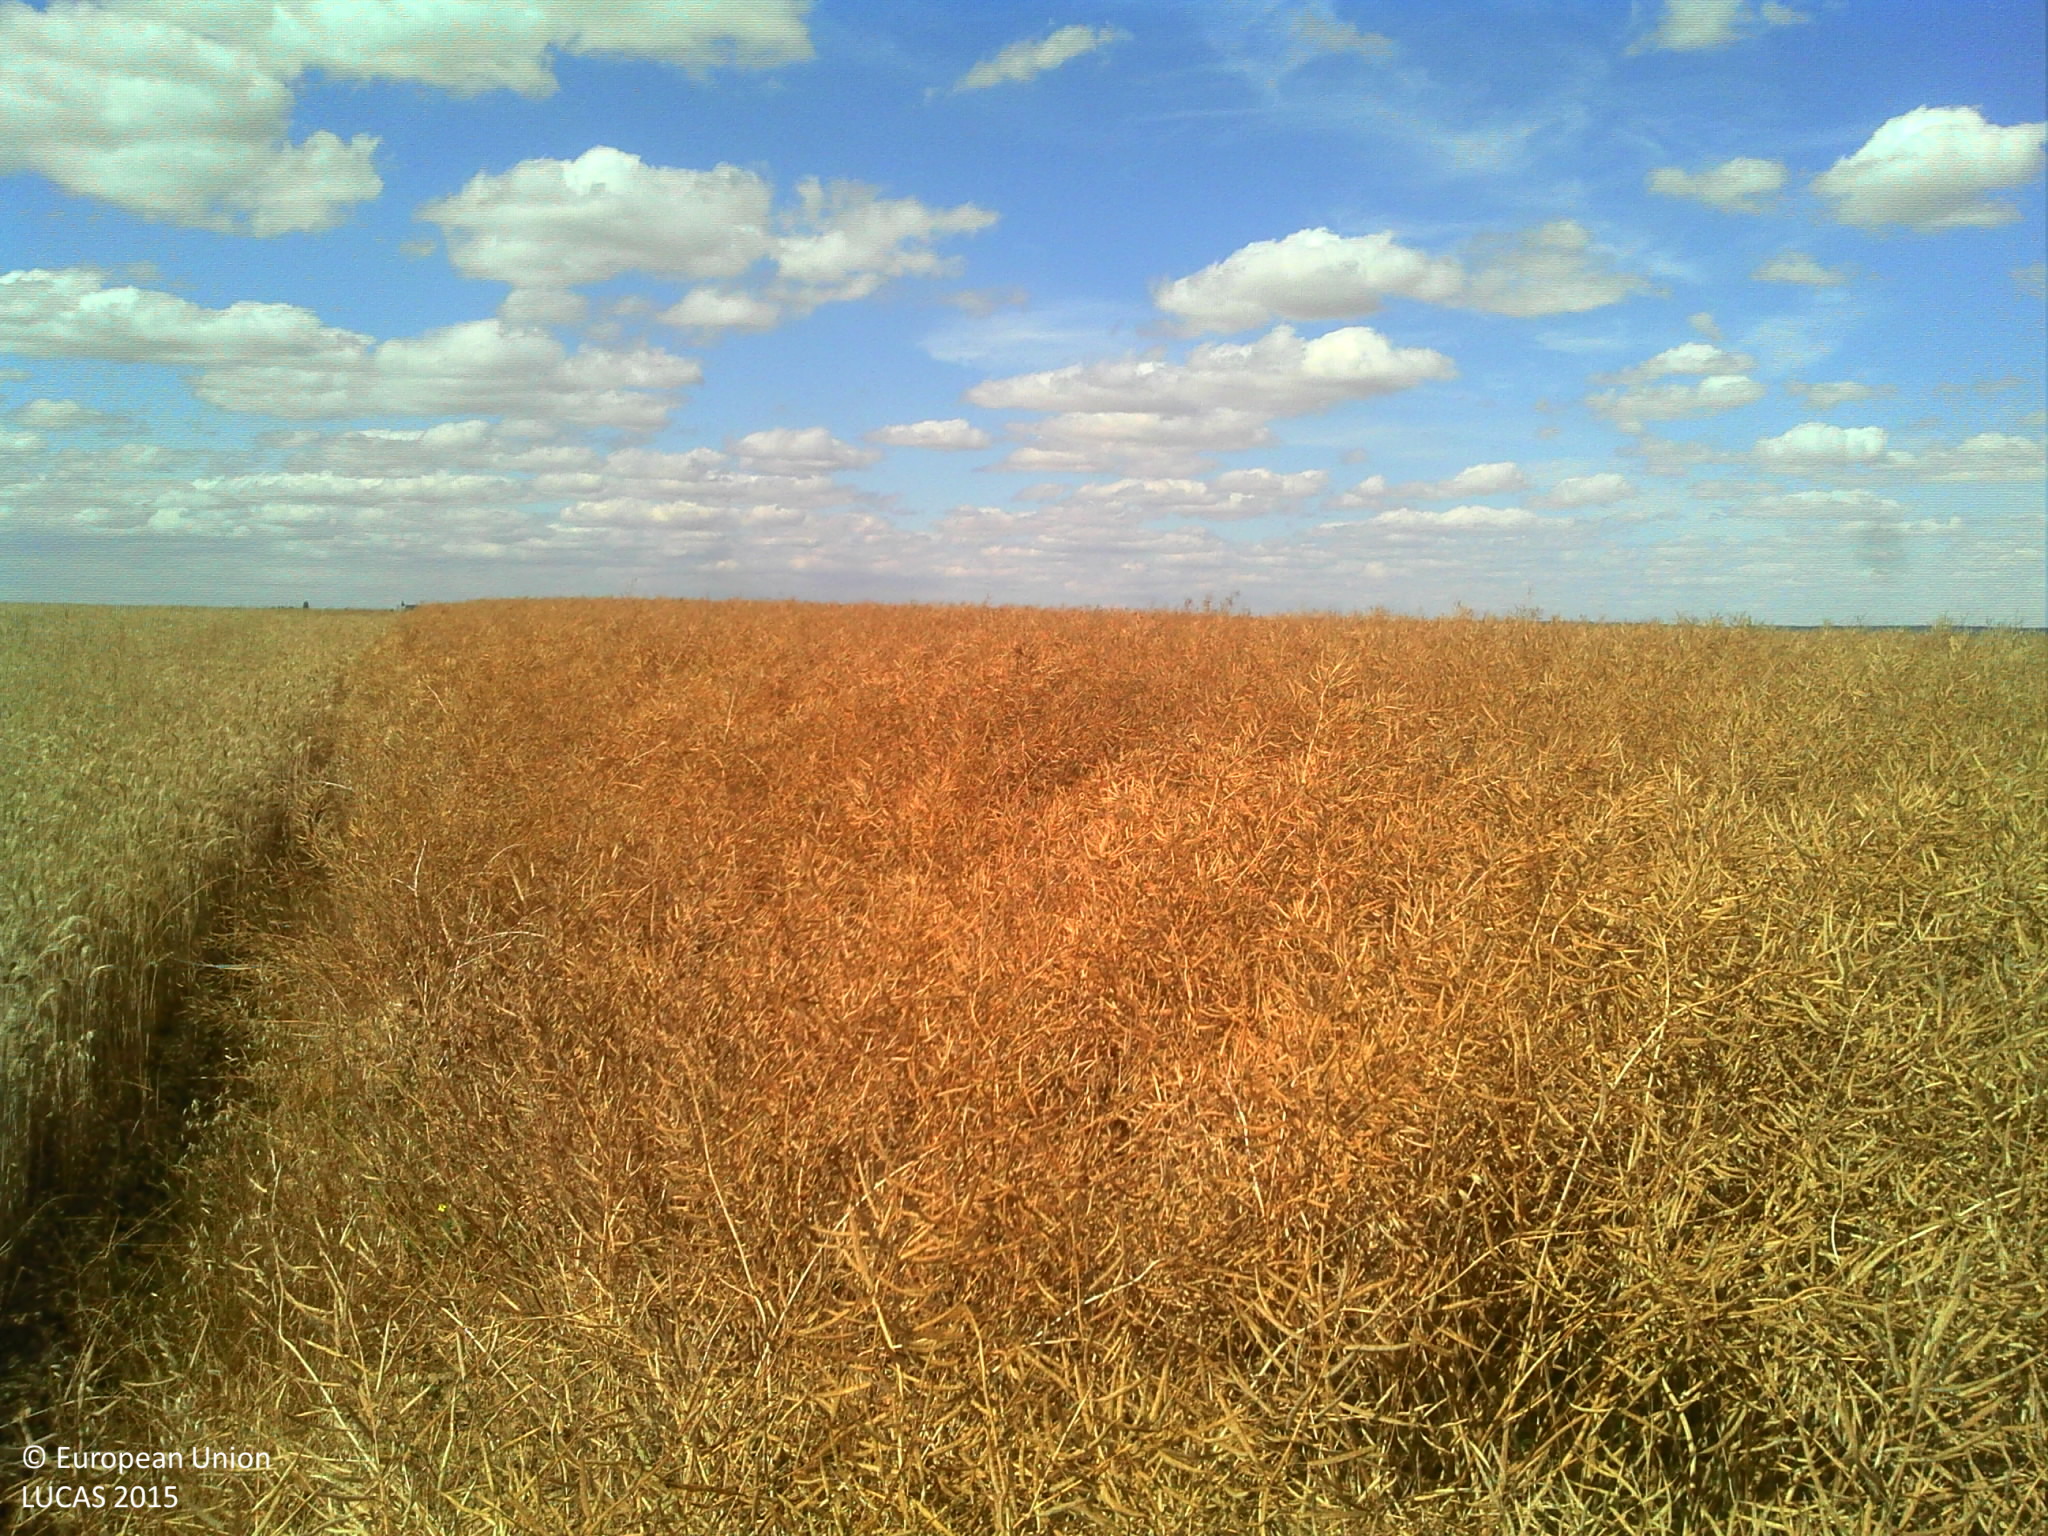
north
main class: Cropland
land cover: Rape and turnip rape
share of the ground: > 75 %
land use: Agriculture (excluding fallow land and kitchen gardens)
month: July
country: FR
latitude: 48.4015
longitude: 1.2694
